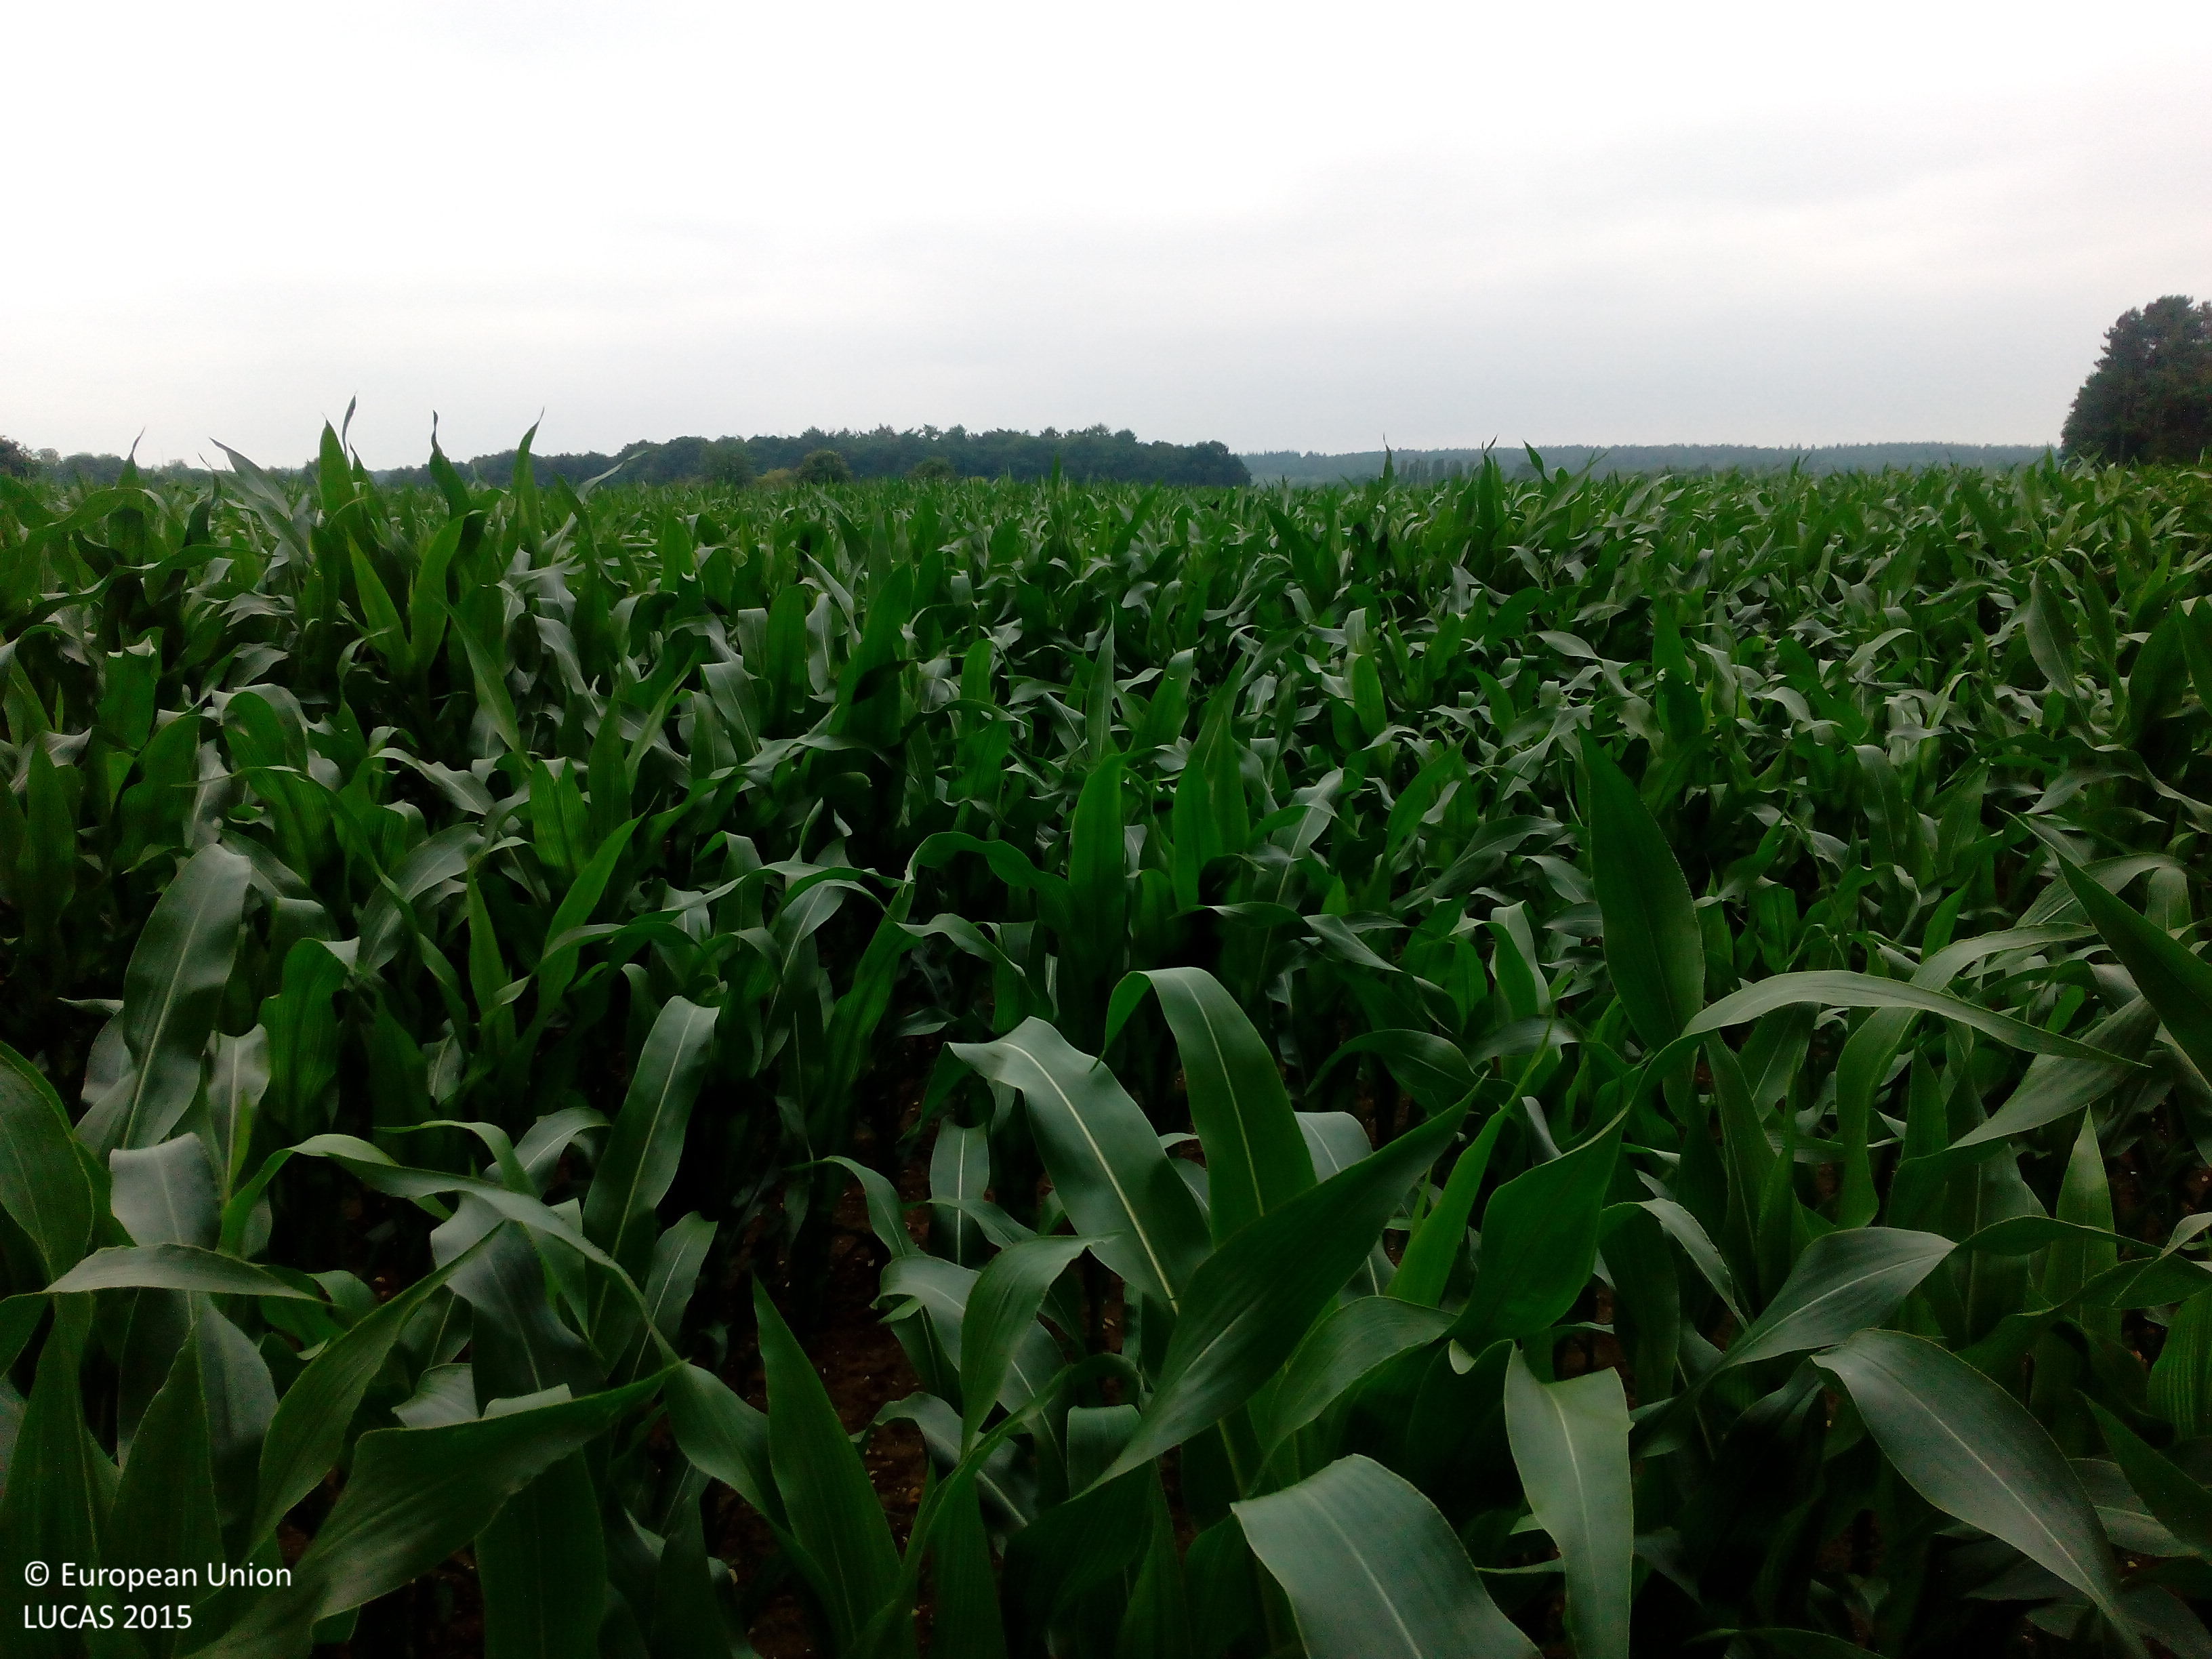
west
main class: Cropland
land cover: Maize
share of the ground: > 75 %
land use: Agriculture (excluding fallow land and kitchen gardens)
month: July
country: NL
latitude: 51.8860
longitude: 6.2364
